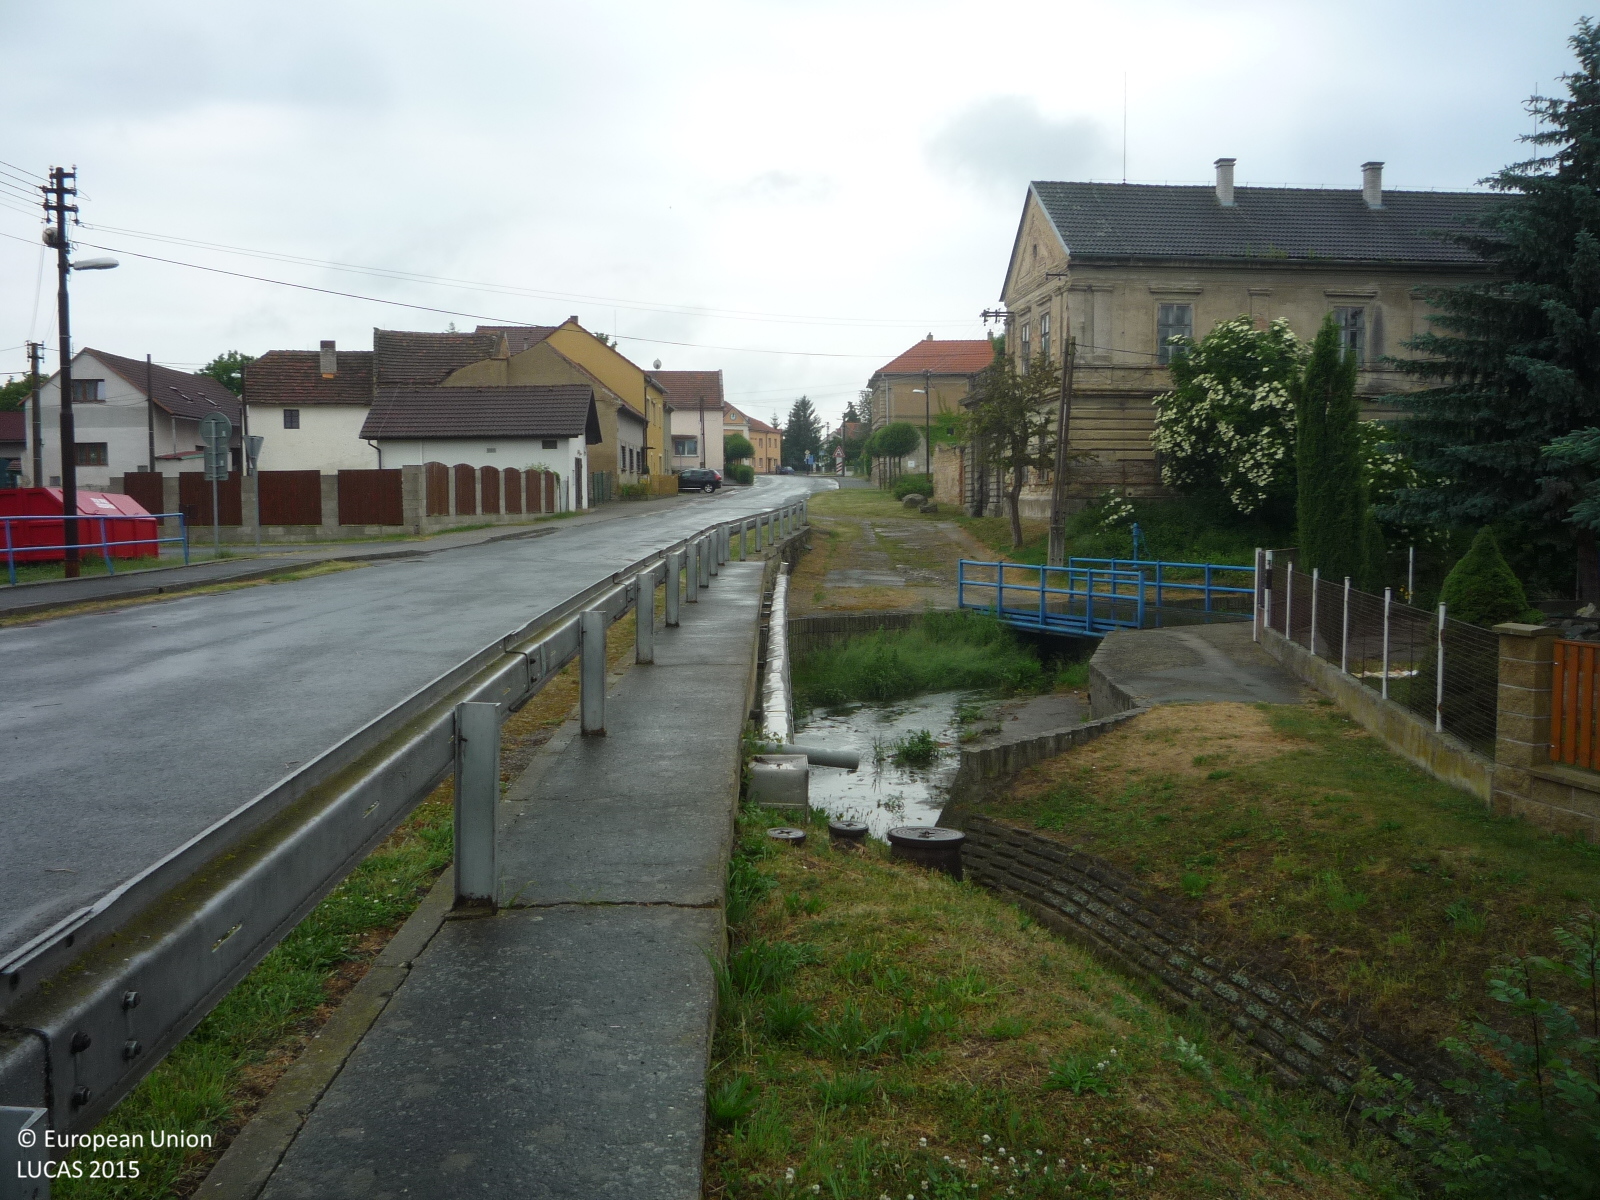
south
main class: Grassland
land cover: Grassland without tree/shrub cover
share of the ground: > 75 %
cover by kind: herbaceous plants 100 %
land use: Road transport
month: June
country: CZ
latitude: 50.3060
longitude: 14.1713
